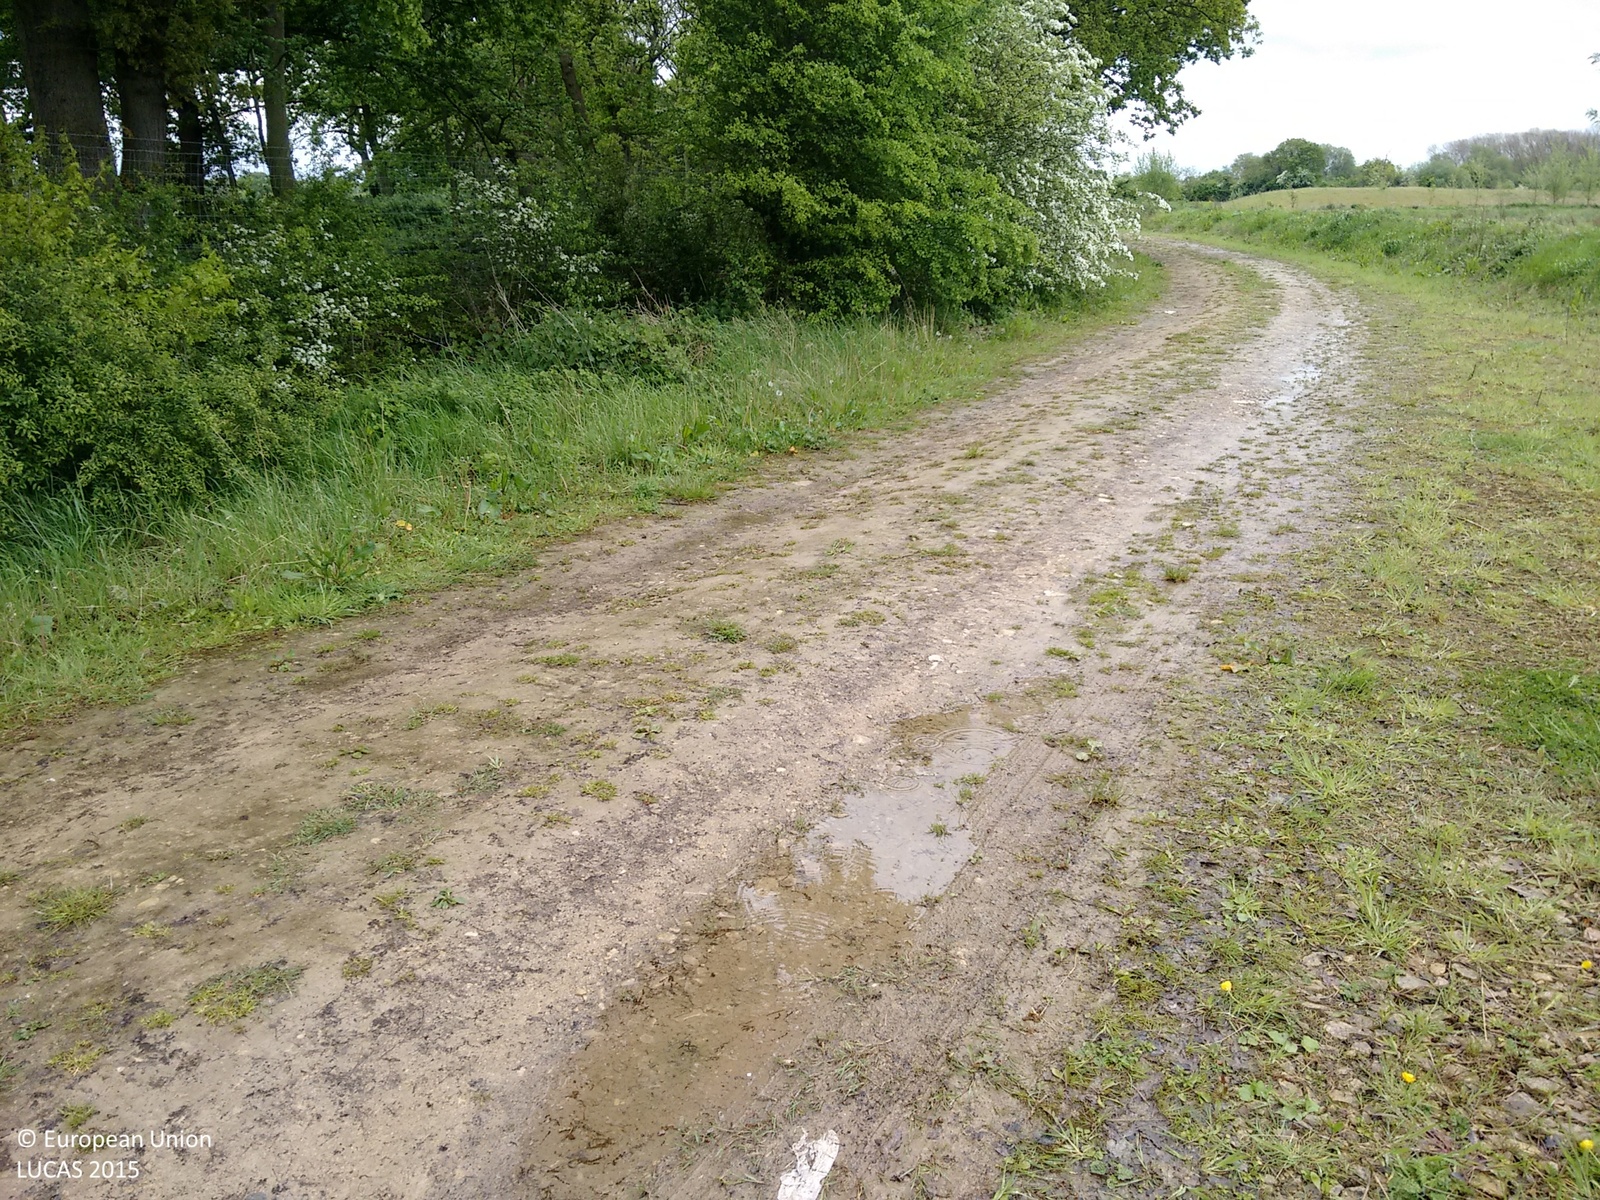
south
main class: Grassland
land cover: Grassland without tree/shrub cover
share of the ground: > 75 %
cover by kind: herbaceous plants 100 %
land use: Agriculture (excluding fallow land and kitchen gardens)
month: May
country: GB
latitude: 53.6138
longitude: -1.1249
